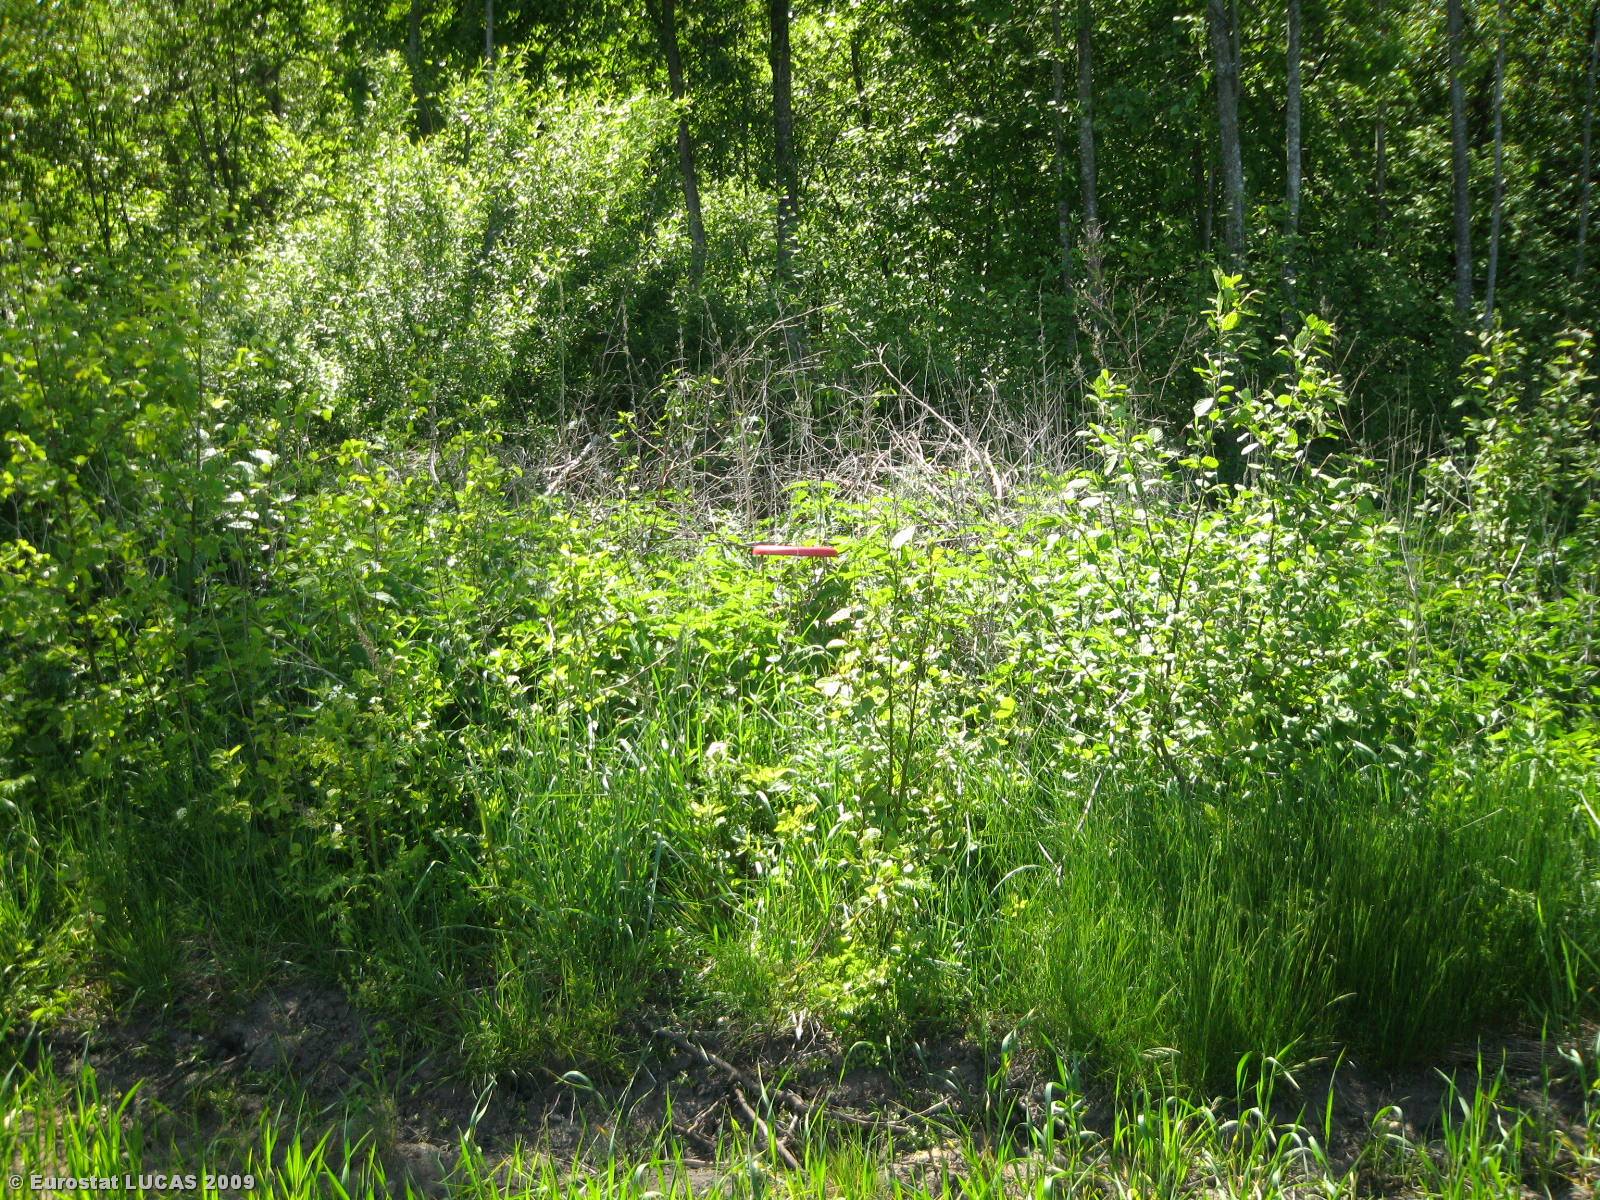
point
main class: Shrubland
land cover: Shrubland with sparse tree cover
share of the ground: > 75 %
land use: Unused
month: May
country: LT
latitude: 55.7657
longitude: 23.9698
